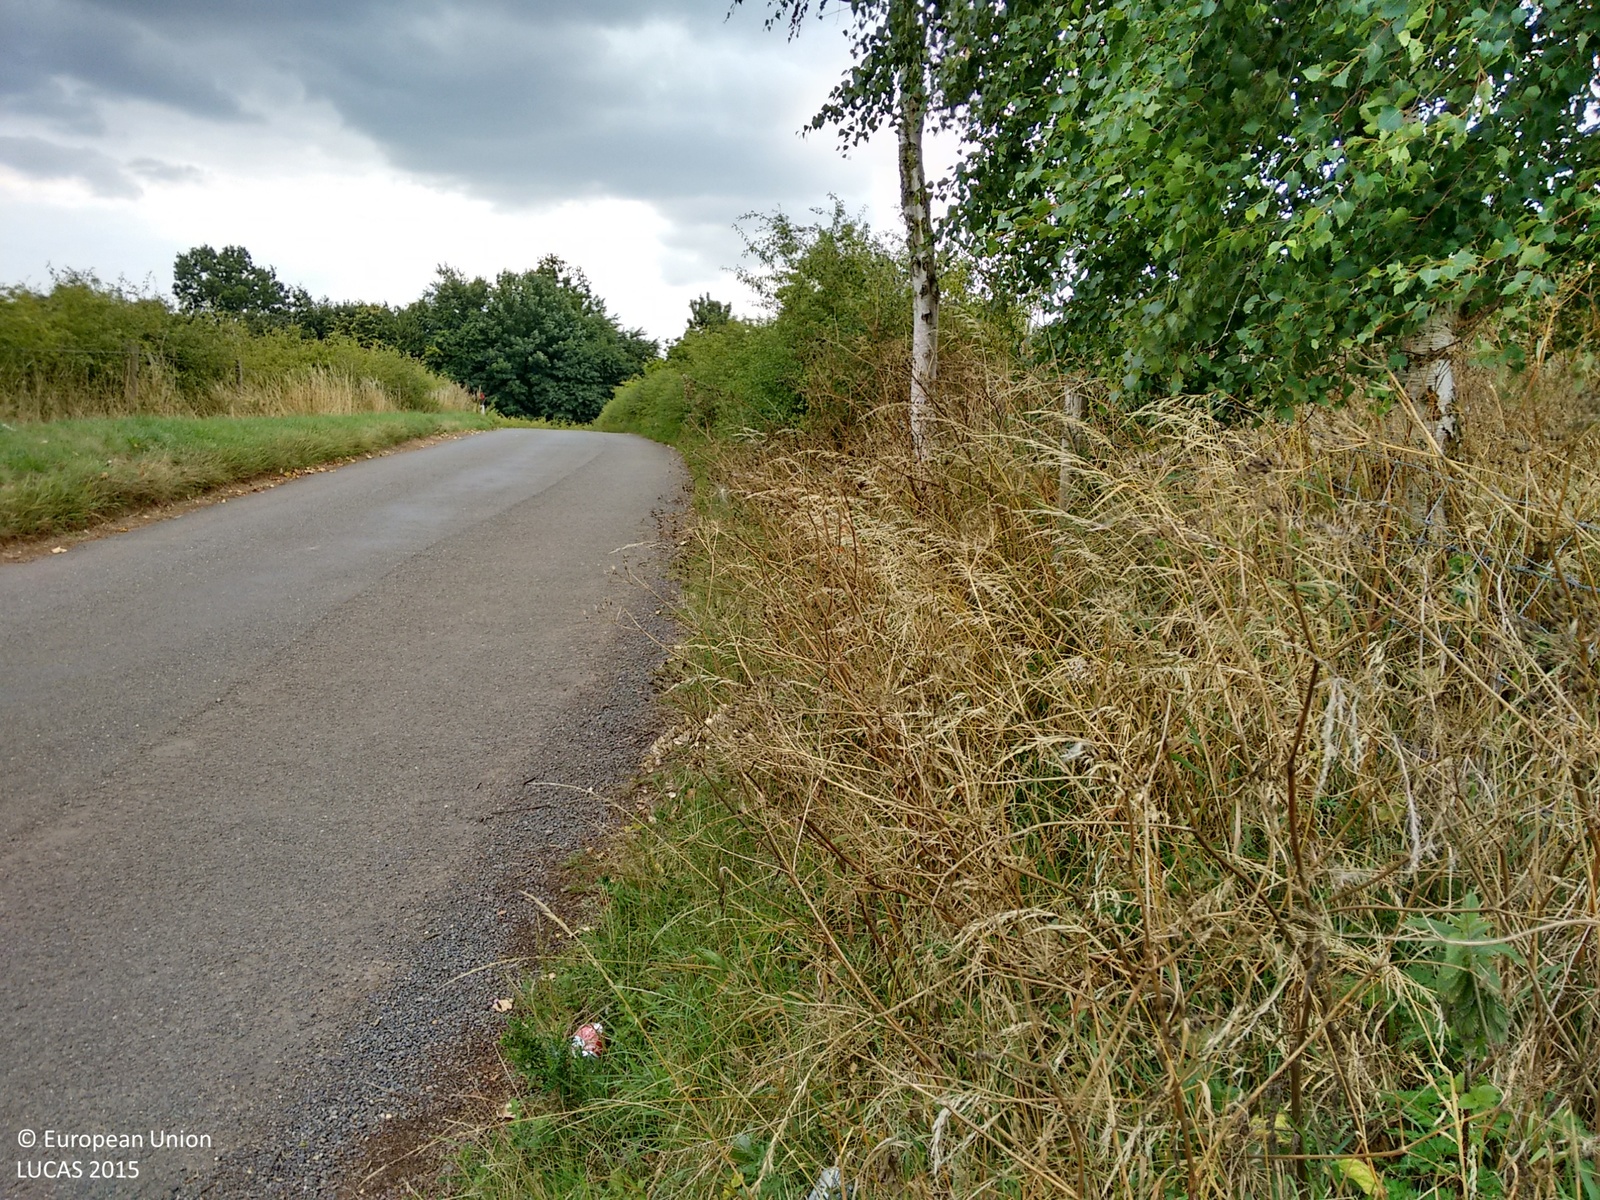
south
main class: Shrubland
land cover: Shrubland with sparse tree cover
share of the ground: > 75 %
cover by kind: shrubs 75 %, herbaceous plants 20 %, broadleaved forest trees 5 %
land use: Semi-natural and natural areas not in use
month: August
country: GB
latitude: 52.4078
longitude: -0.8170
